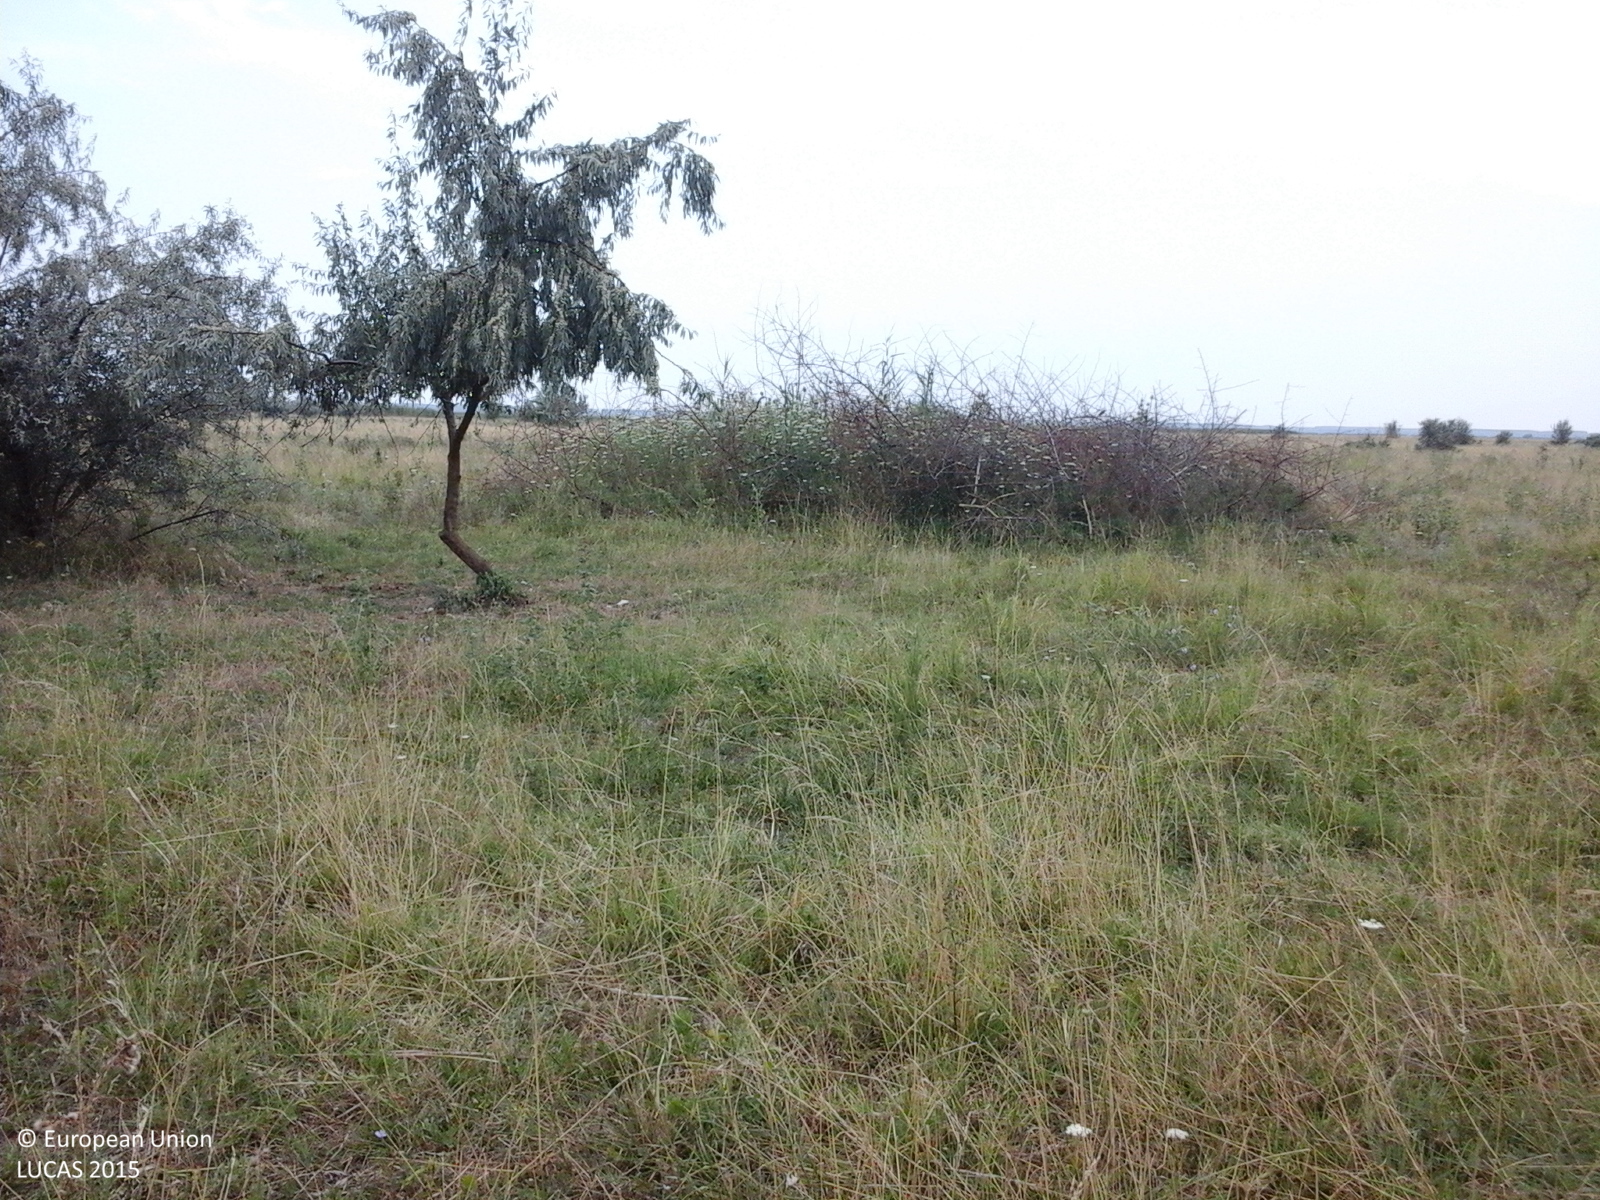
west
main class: Grassland
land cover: Grassland with sparse tree/shrub cover
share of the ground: > 75 %
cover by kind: herbaceous plants 85 %, shrubs 10 %, broadleaved forest trees 5 %
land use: Semi-natural and natural areas not in use
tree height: > 5 m
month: July
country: RO
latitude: 45.0645
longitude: 28.2180
